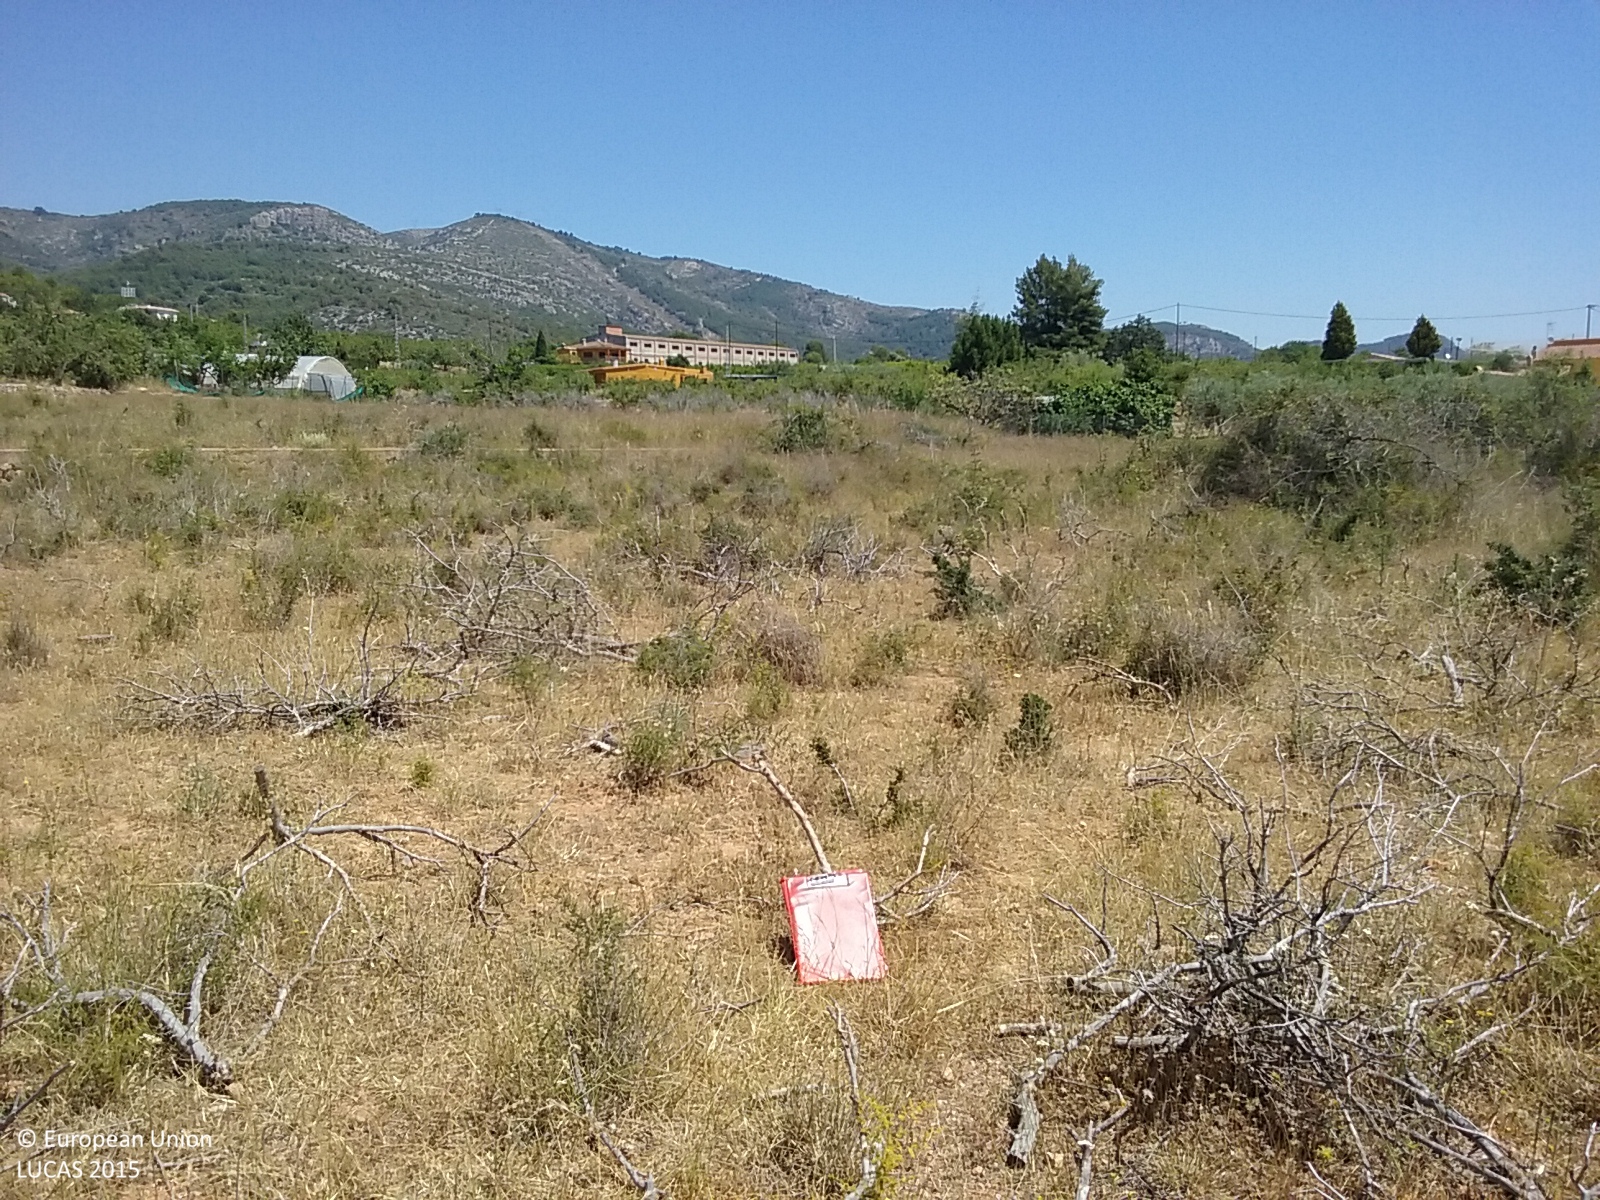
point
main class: Shrubland
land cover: Shrubland without tree cover
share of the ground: 10 - 25 %
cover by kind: herbaceous plants 80 %, shrubs 15 %, unconsolidated bare surface 5 %
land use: Abandoned areas
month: June
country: ES
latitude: 40.0598
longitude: -0.0488
